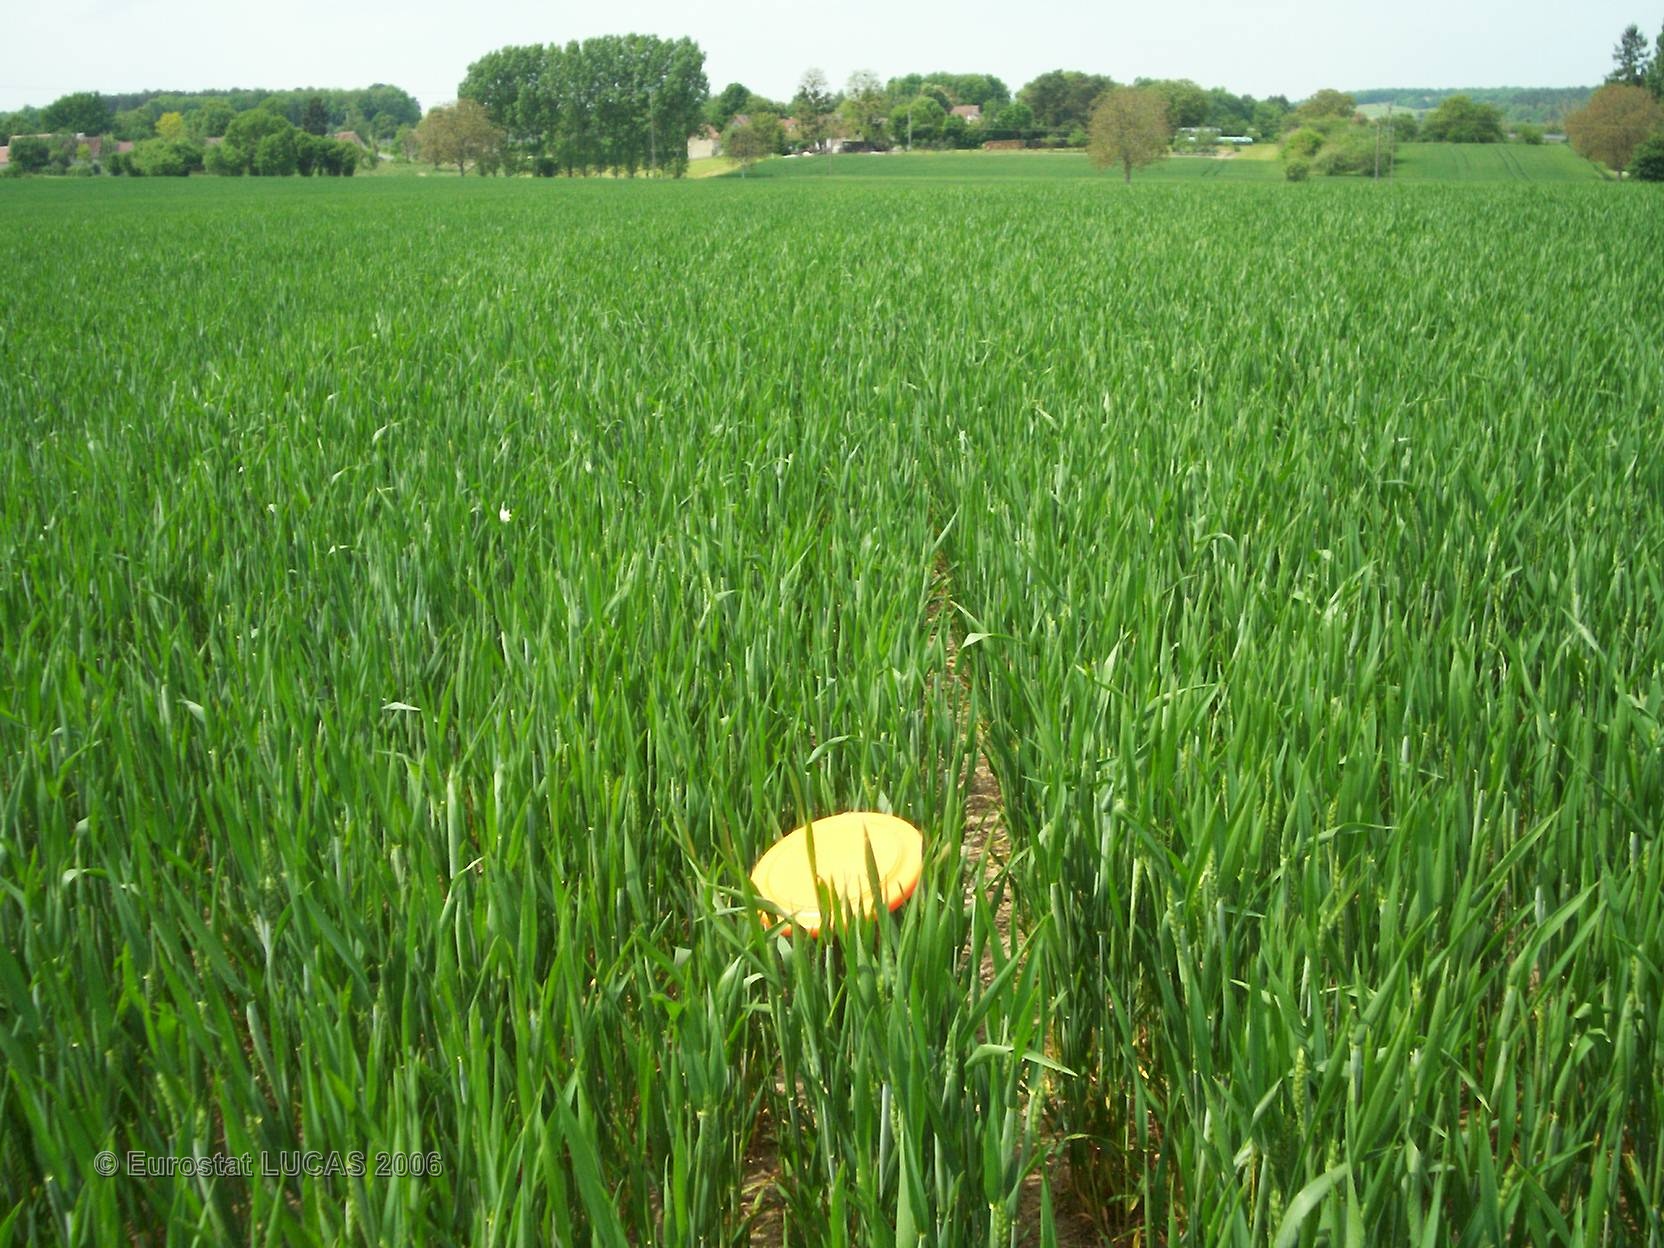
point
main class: Cropland
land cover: Common wheat
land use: Agriculture (excluding fallow land and kitchen gardens)
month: May
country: FR
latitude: 46.8053
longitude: 1.0092
